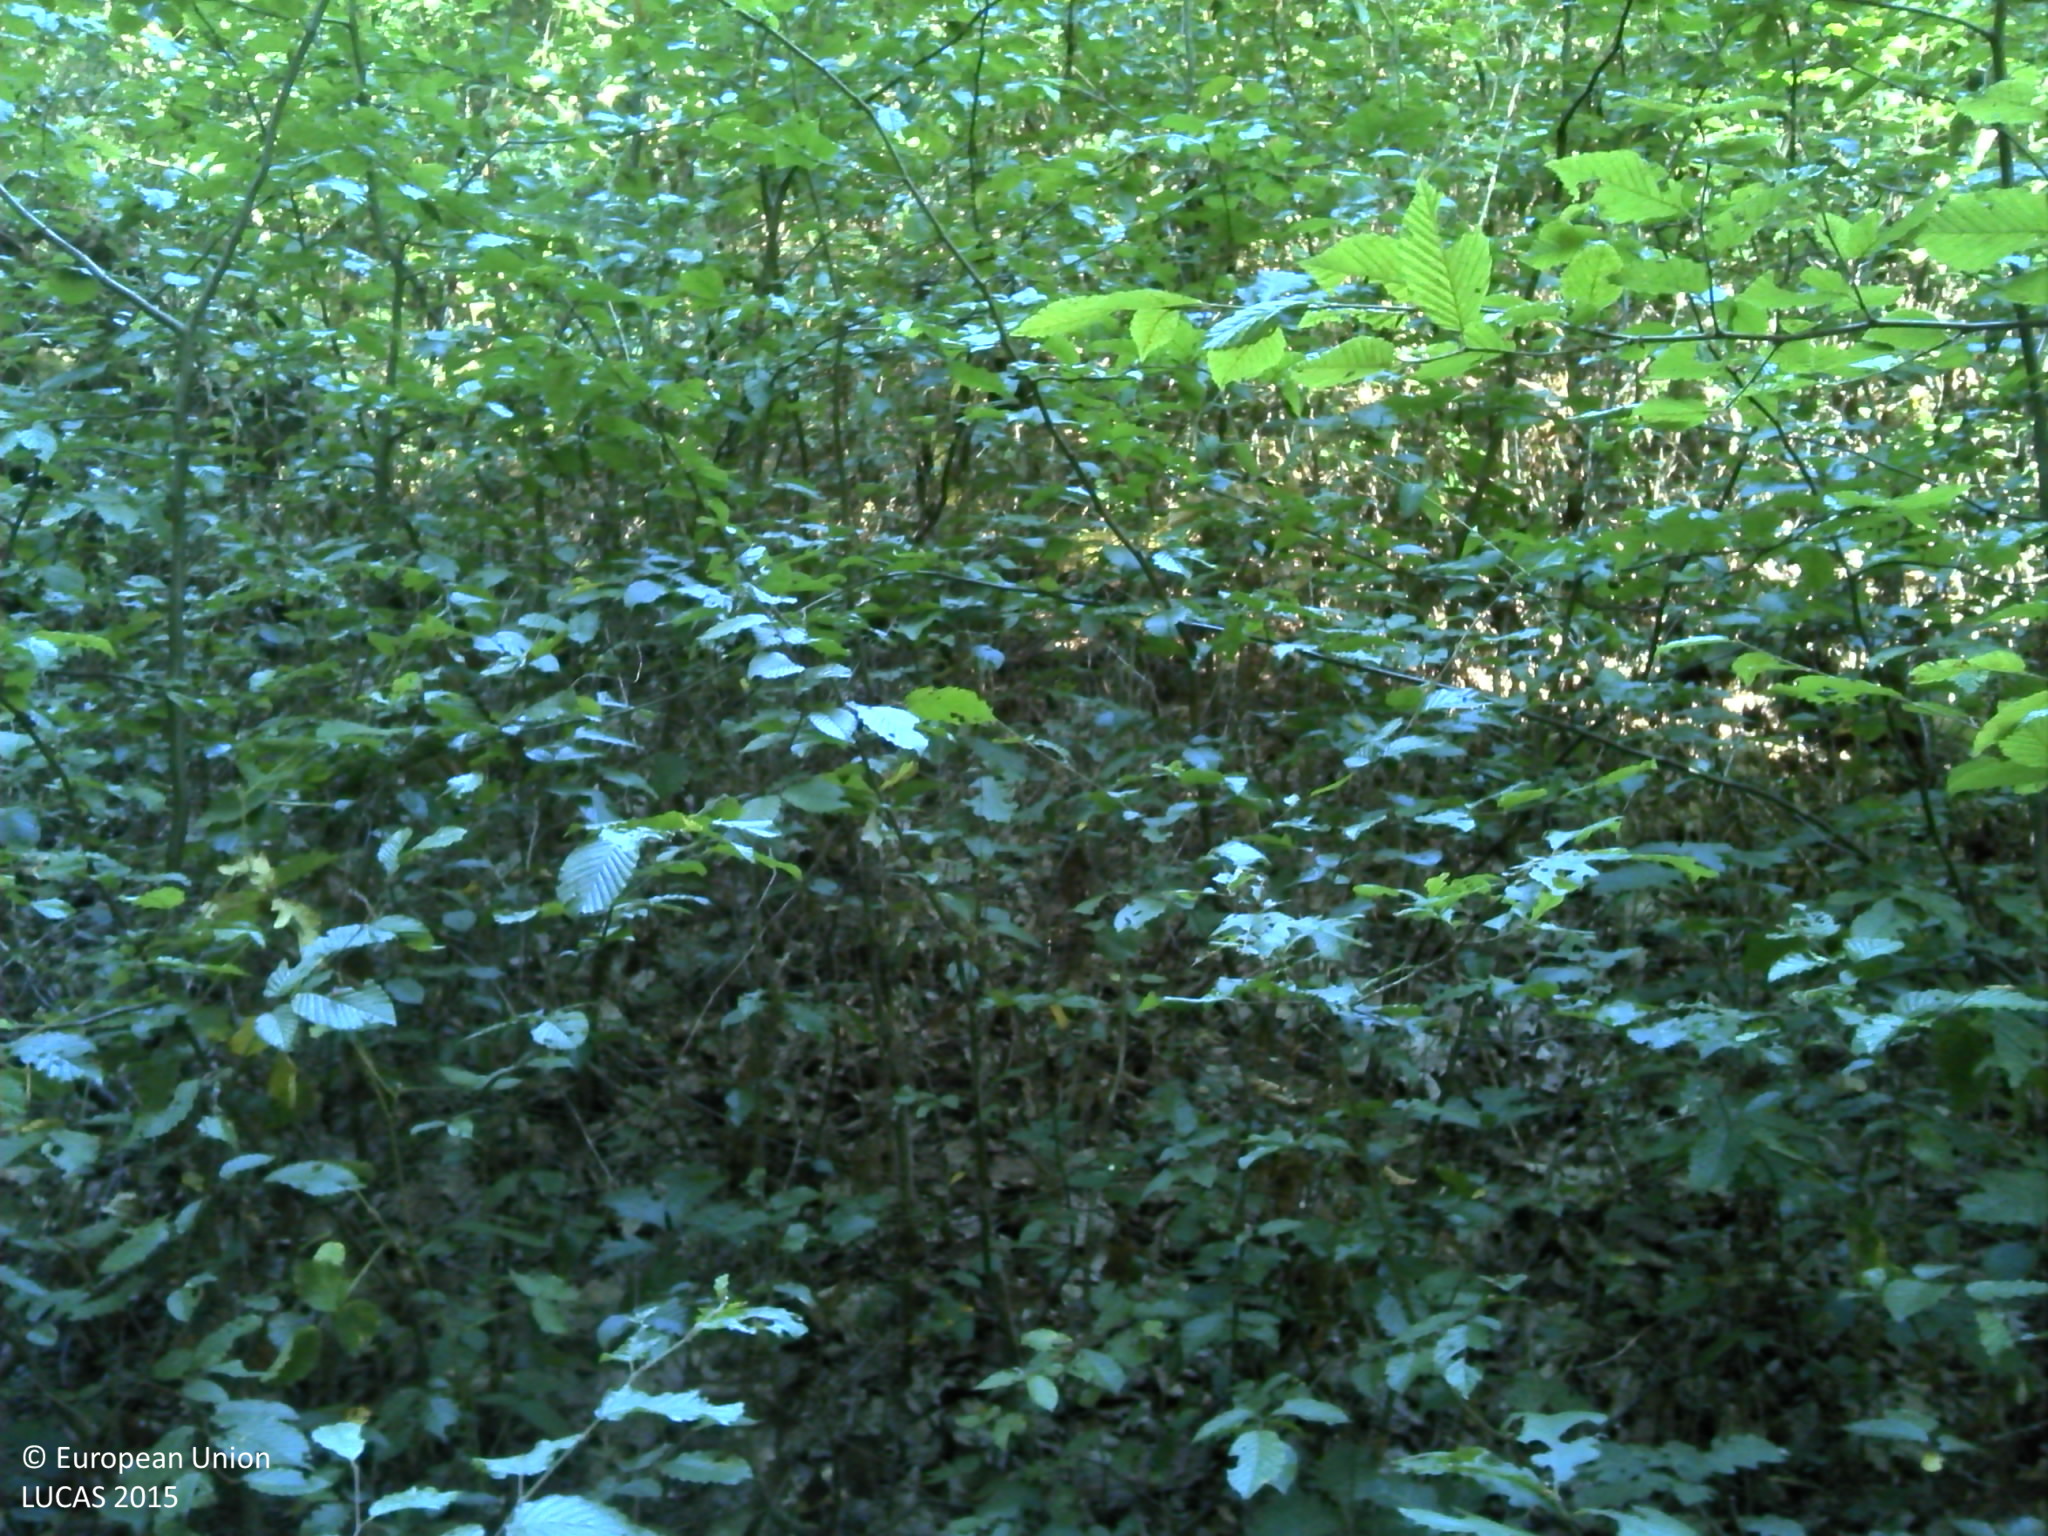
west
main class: Woodland
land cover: Broadleaved woodland
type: mesophytic deciduous forest
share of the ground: > 75 %
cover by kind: broadleaved forest trees 80 %, shrubs 15 %, herbaceous plants 5 %
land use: Forestry
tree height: > 5 m
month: August
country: FR
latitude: 48.7166
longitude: 1.8436
